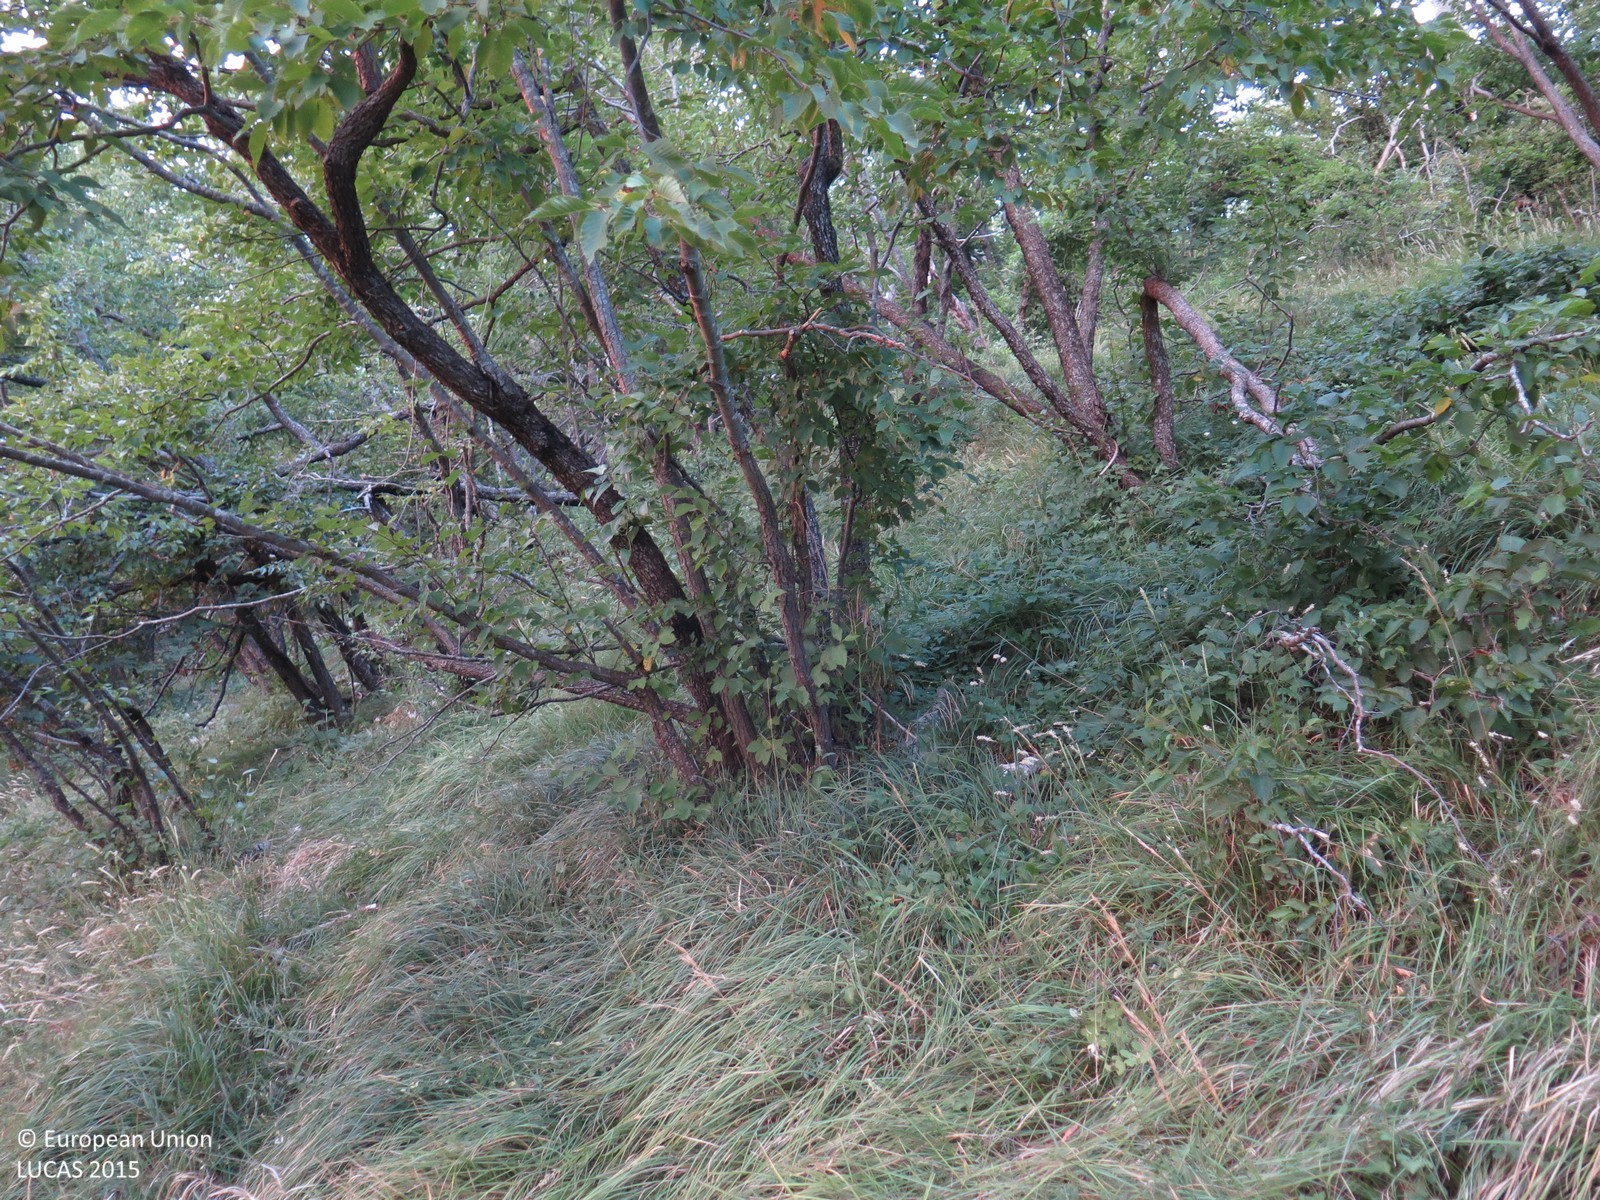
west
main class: Shrubland
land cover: Shrubland with sparse tree cover
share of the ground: > 75 %
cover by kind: shrubs 90 %, broadleaved forest trees 5 %, herbaceous plants 5 %
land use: Semi-natural and natural areas not in use
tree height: > 5 m
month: August
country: HR
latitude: 45.3083
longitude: 14.7269
